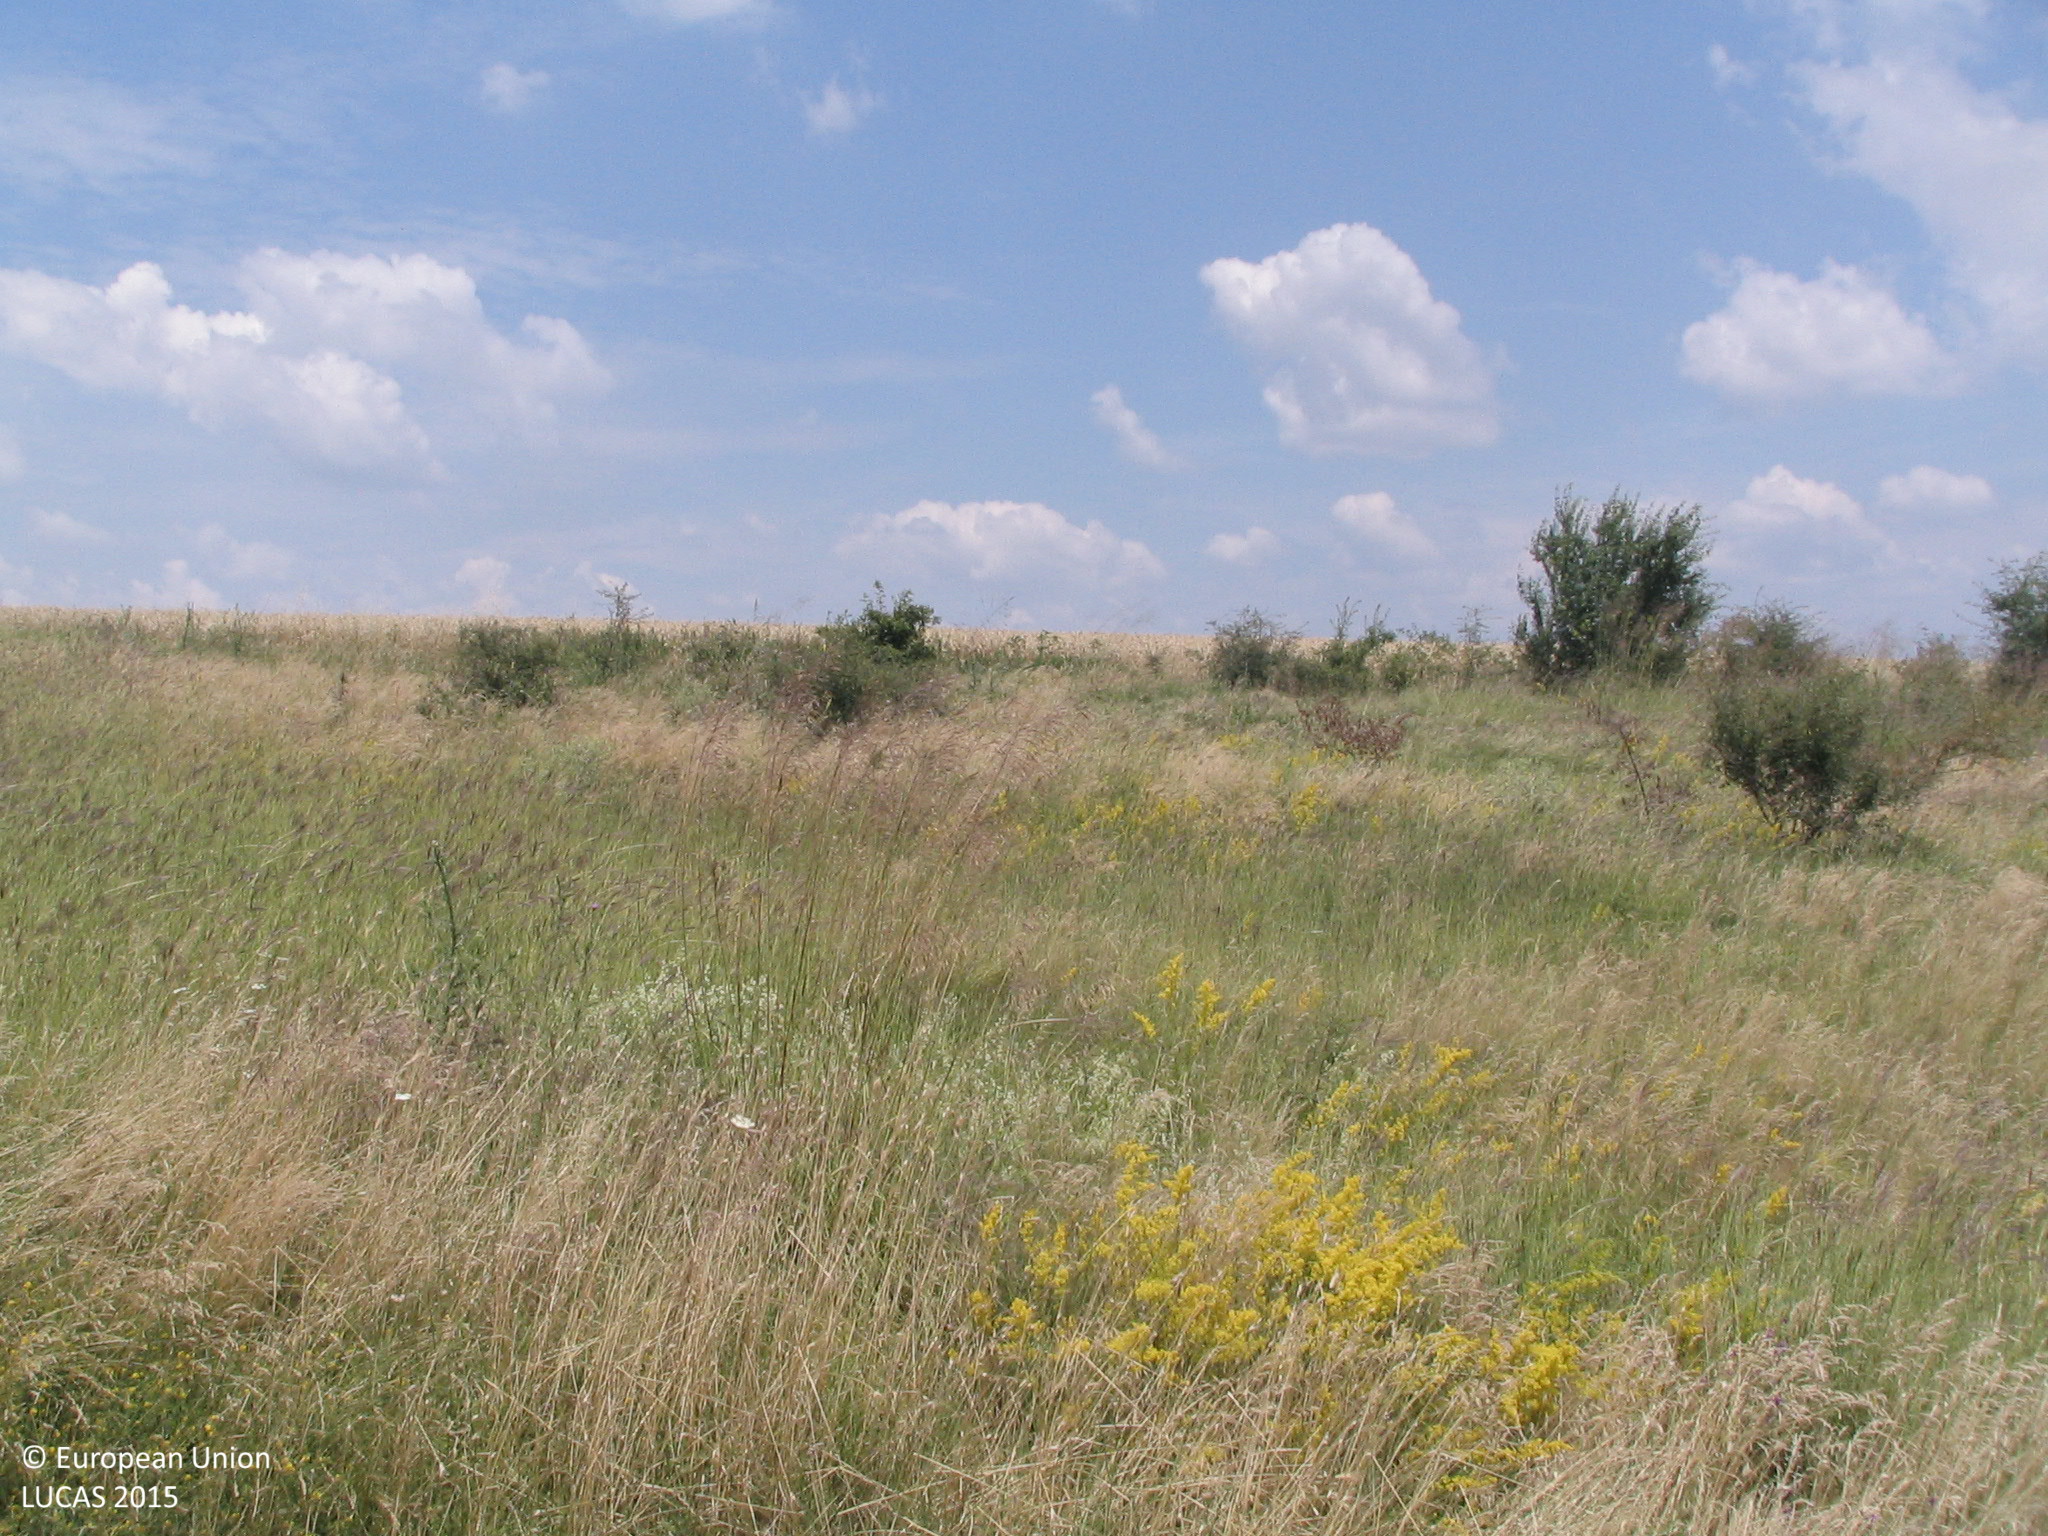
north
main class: Grassland
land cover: Grassland without tree/shrub cover
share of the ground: > 75 %
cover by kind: herbaceous plants 95 %, shrubs 5 %
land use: Semi-natural and natural areas not in use
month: June
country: BG
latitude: 43.3232
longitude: 23.9980
